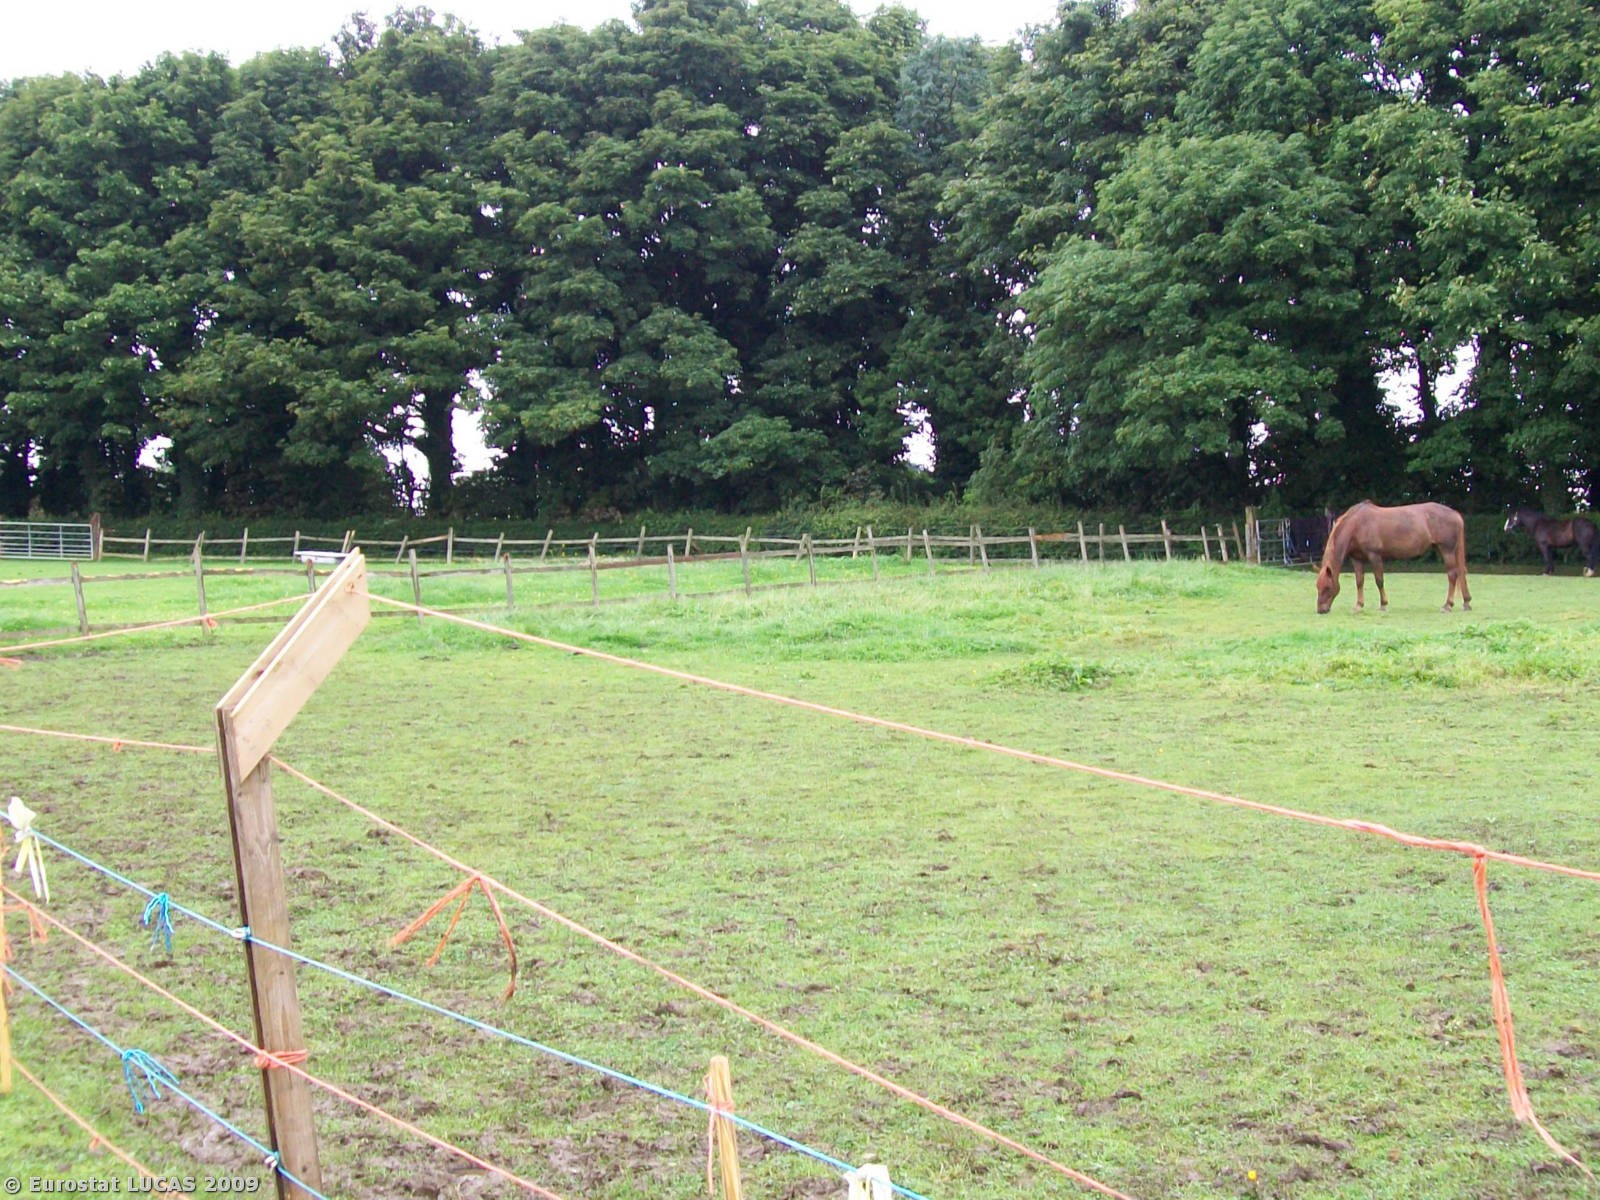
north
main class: Grassland
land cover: Grassland without tree/shrub cover
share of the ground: > 75 %
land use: Agriculture (excluding fallow land and kitchen gardens)
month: August
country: GB
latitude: 53.2904
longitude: -1.2834
